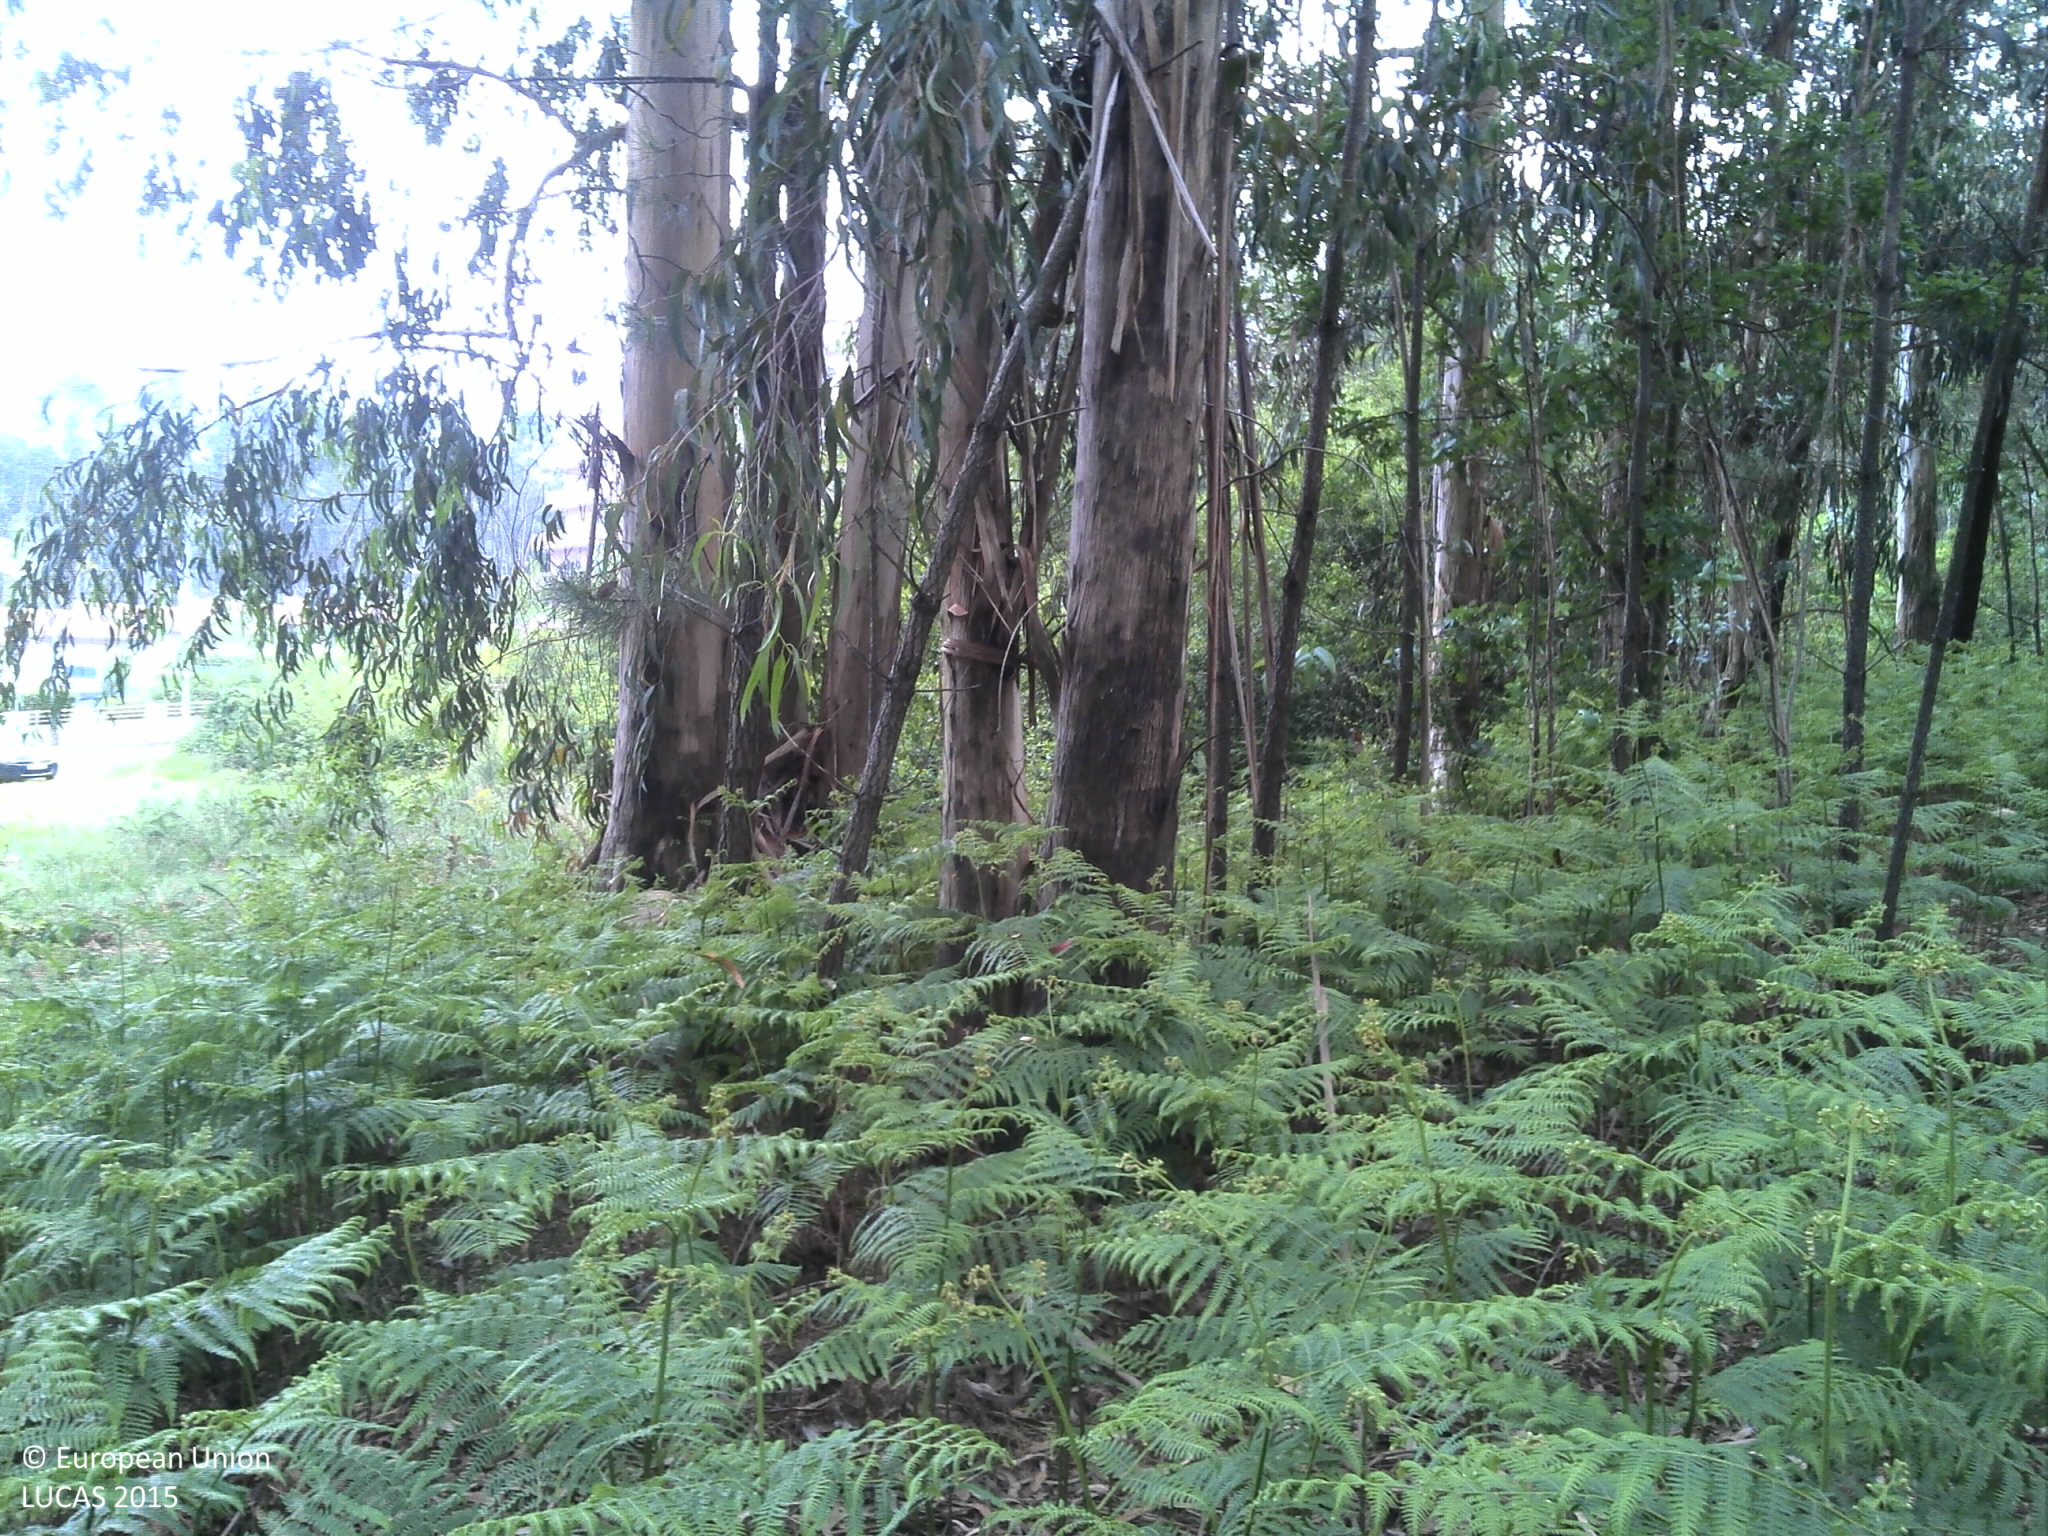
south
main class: Woodland
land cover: Broadleaved woodland
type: exotic forest
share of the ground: > 75 %
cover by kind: broadleaved forest trees 80 %, shrubs 10 %, herbaceous plants 5 %, unconsolidated bare surface 5 %
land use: Forestry
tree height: > 5 m
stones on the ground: < 10 %
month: May
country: PT
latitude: 40.9069
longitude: -8.4378
